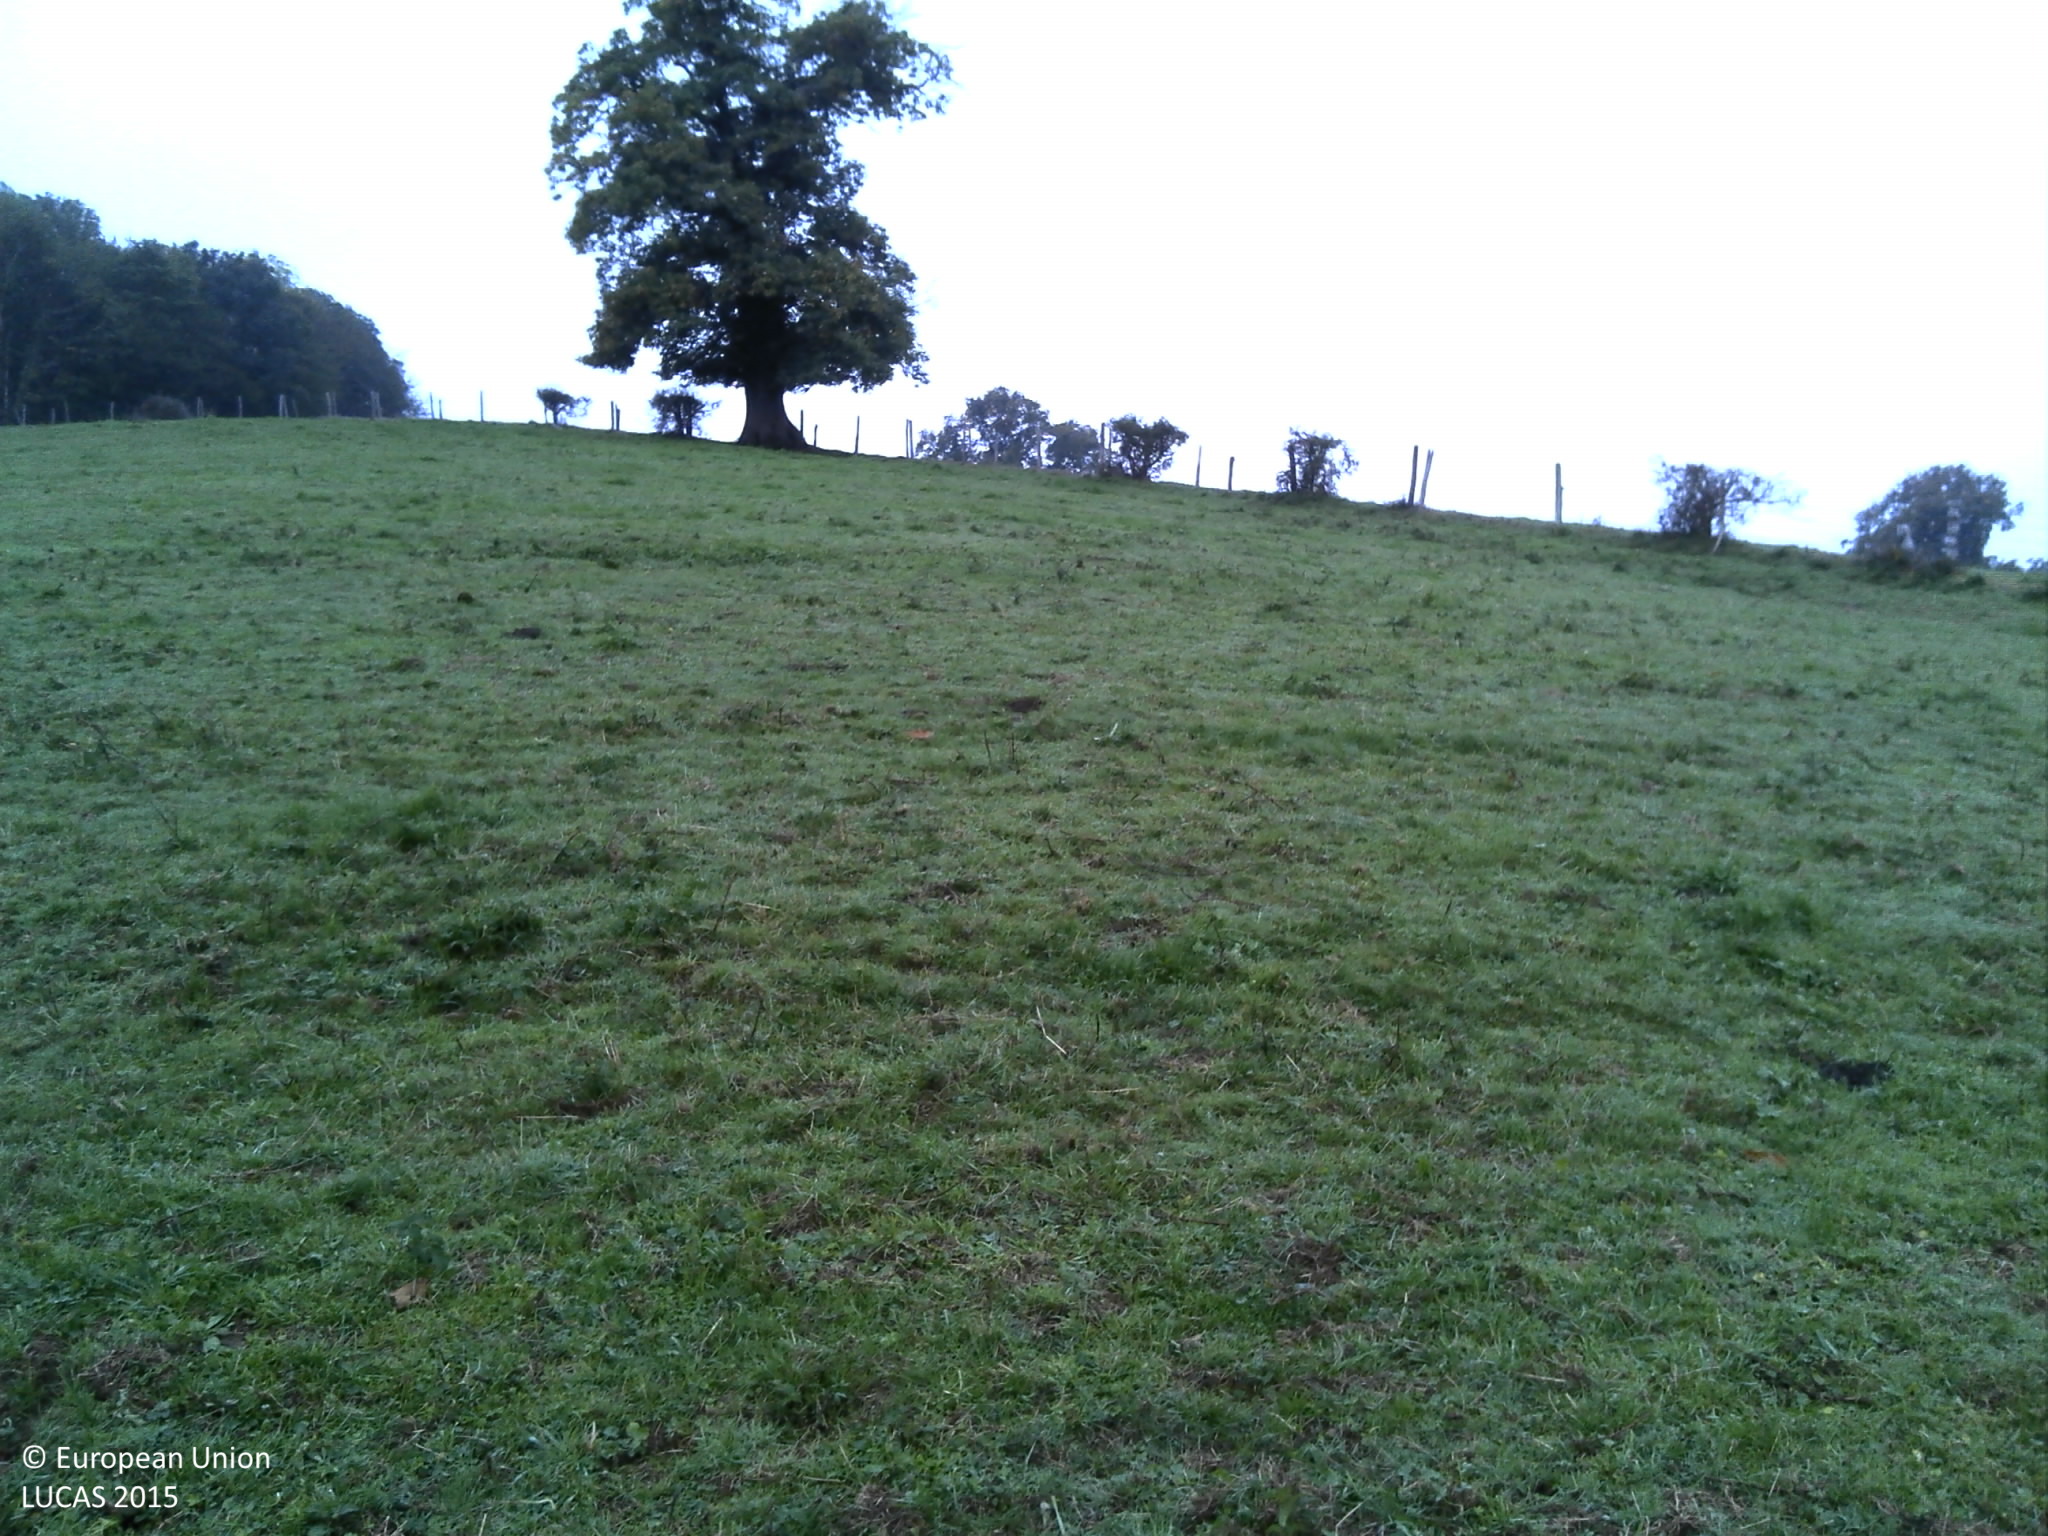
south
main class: Grassland
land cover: Grassland without tree/shrub cover
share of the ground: > 75 %
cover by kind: herbaceous plants 100 %
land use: Agriculture (excluding fallow land and kitchen gardens)
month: October
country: FR
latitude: 46.7615
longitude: 4.0161
